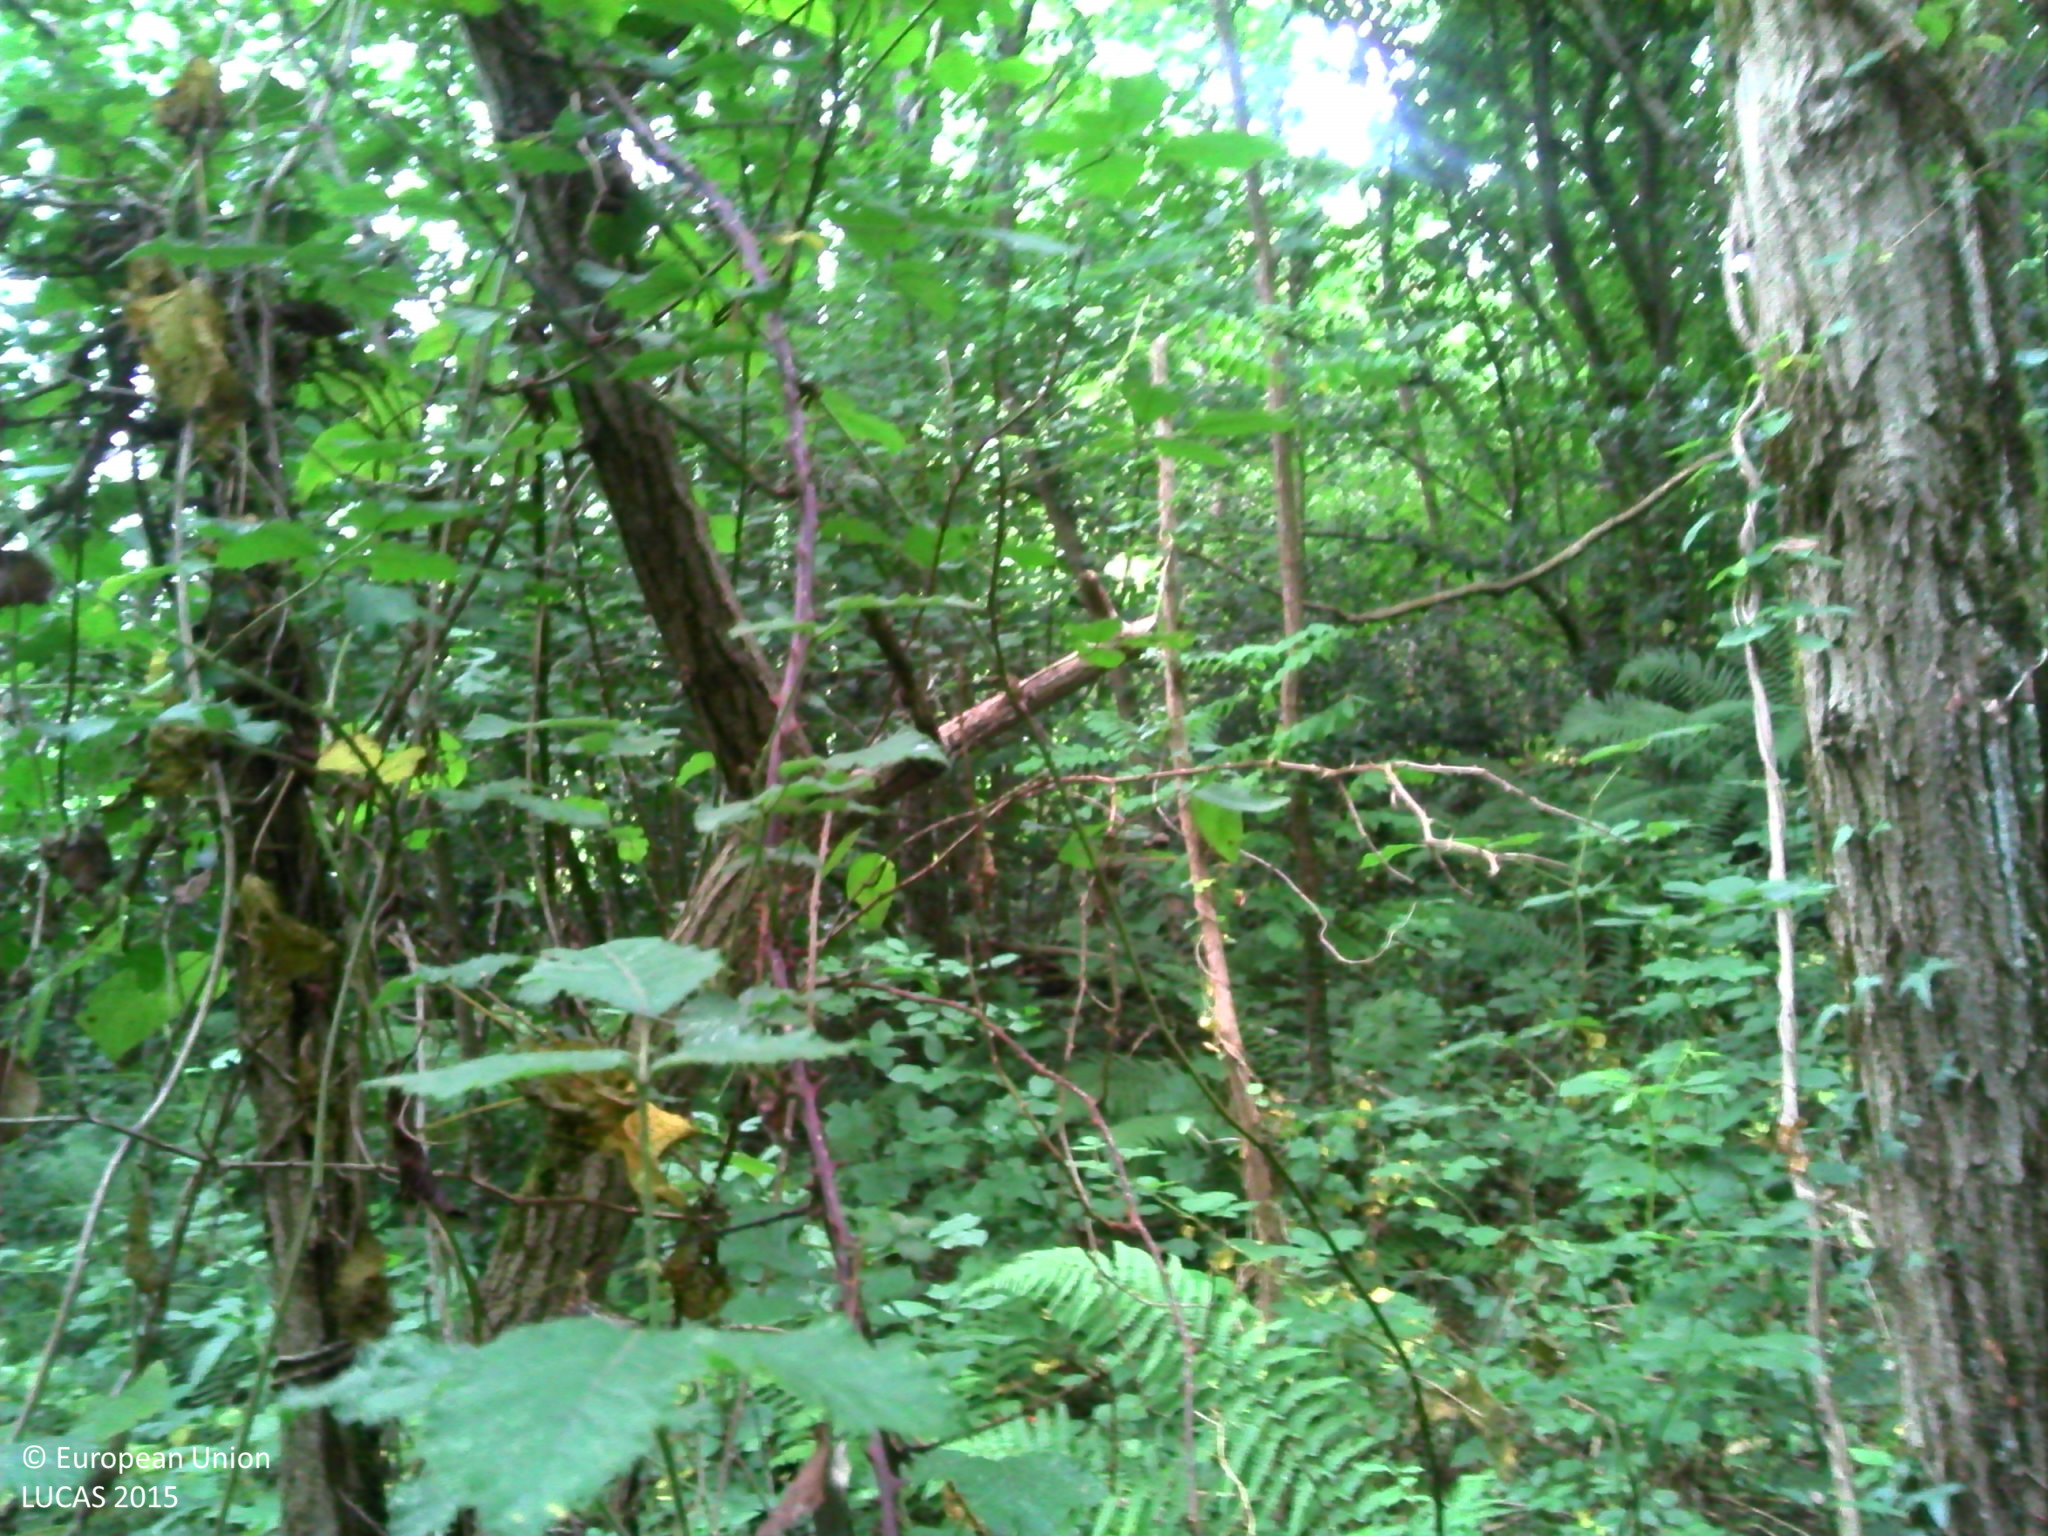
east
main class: Woodland
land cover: Broadleaved woodland
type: thermophilous deciduous forest
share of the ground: > 75 %
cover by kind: broadleaved forest trees 80 %, shrubs 10 %, herbaceous plants 5 %, lichens and mosses 5 %
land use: Forestry
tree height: > 5 m
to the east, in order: Broadleaved woodland; Tracks; Broadleaved woodland; Shrubland with sparse tree cover; Broadleaved woodland; Fences; Broadleaved woodland; Grassland without tree/shrub cover; Fences; Grass margins; Maize
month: August
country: FR
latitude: 43.3371
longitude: -1.0771
